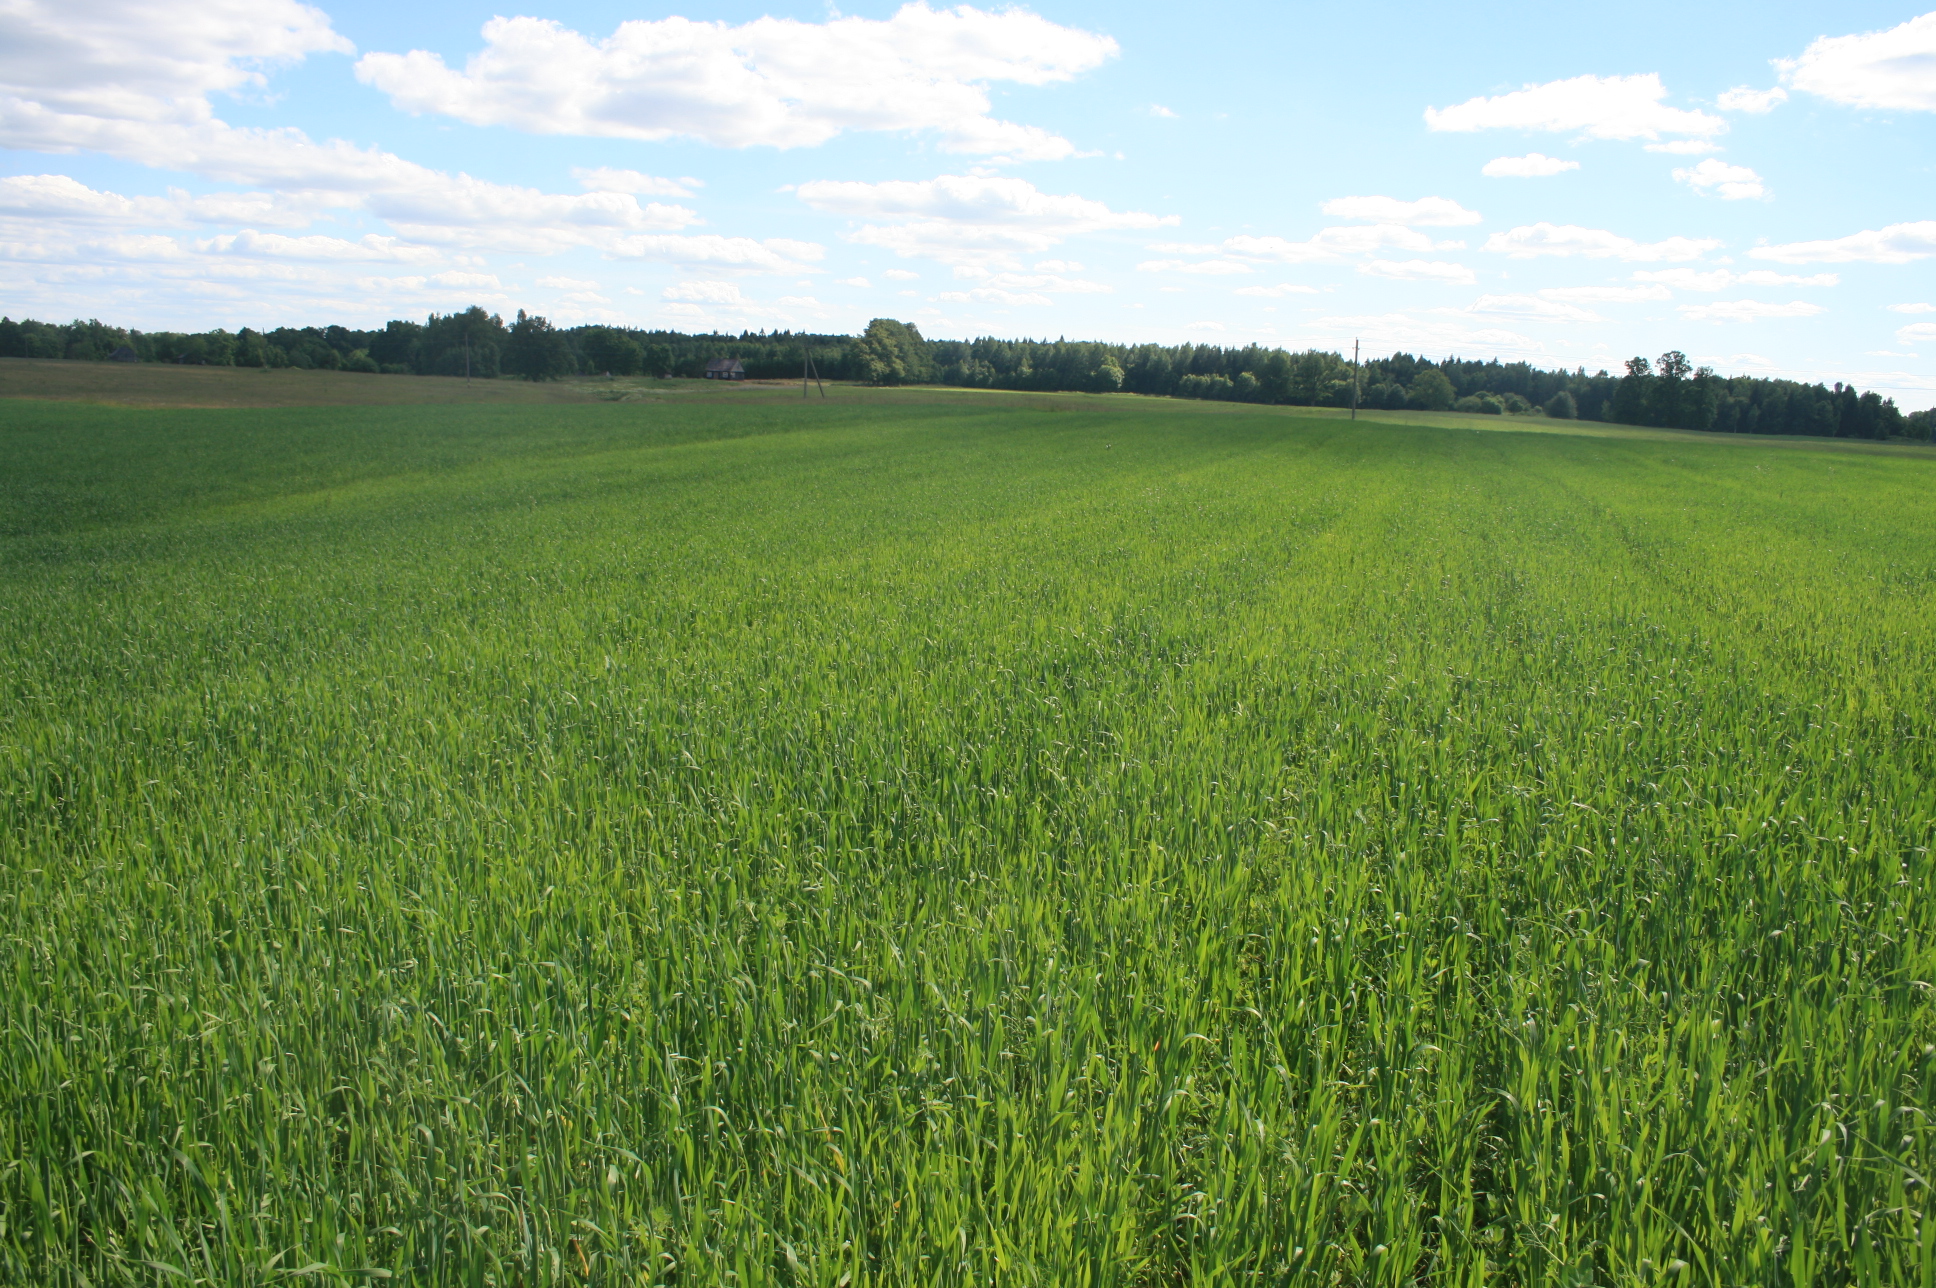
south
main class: Cropland
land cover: Other leguminous and mixtures for fodder
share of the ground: > 75 %
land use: Agriculture (excluding fallow land and kitchen gardens)
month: June
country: LT
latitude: 55.3941
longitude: 22.1014
